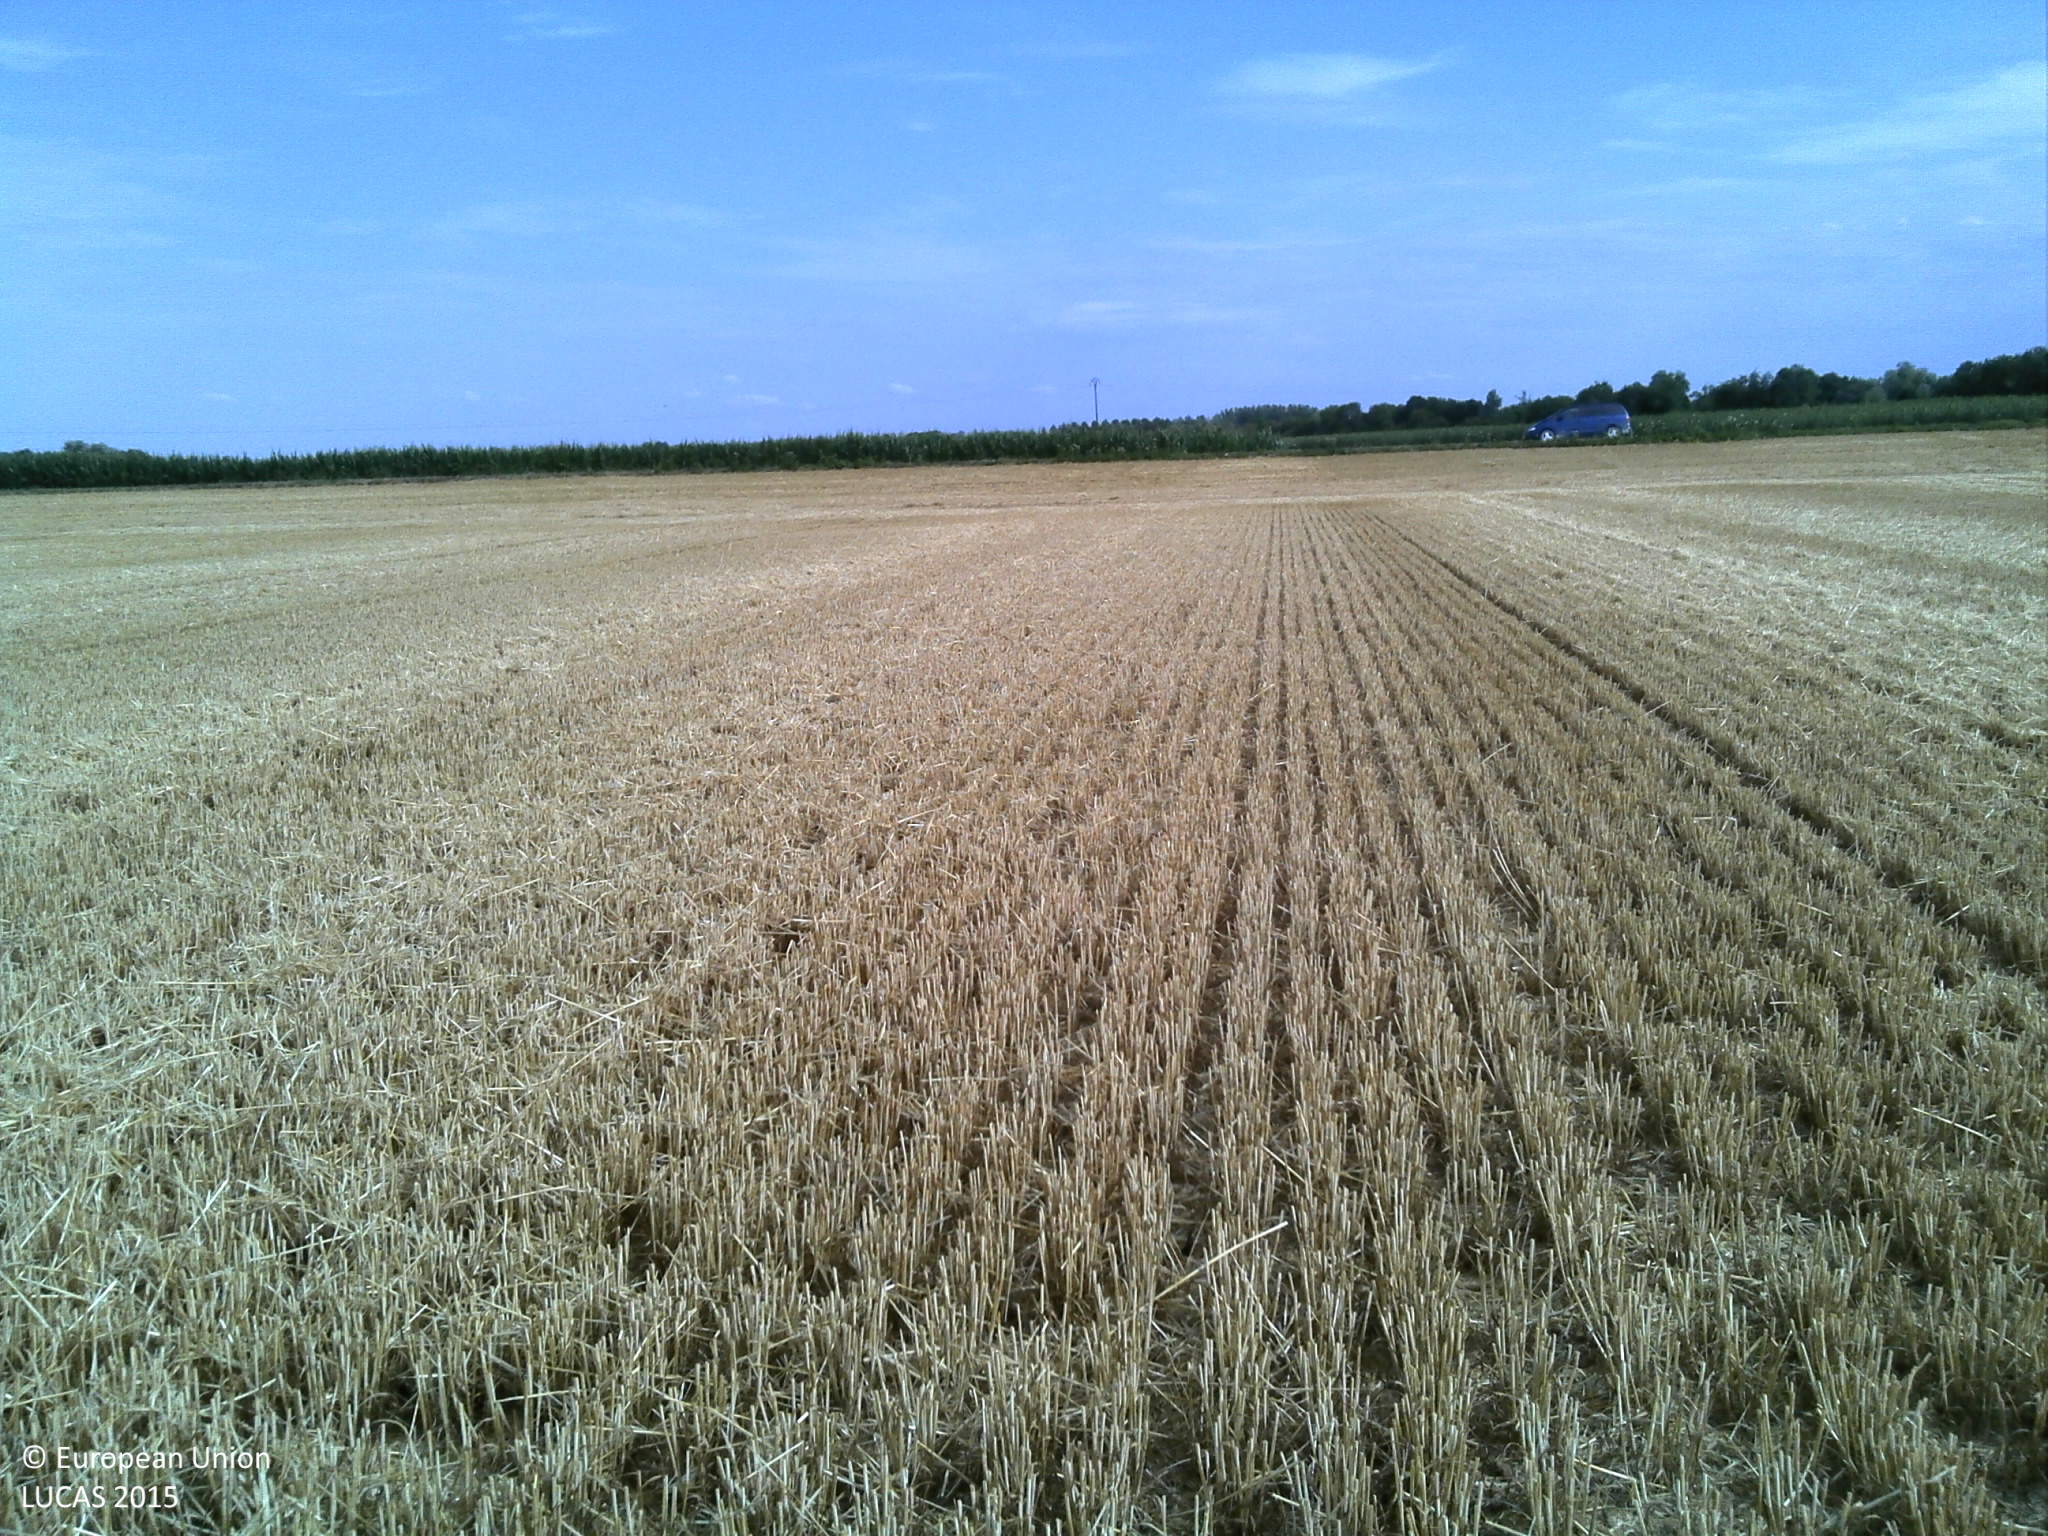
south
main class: Cropland
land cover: Common wheat
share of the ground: > 75 %
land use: Agriculture (excluding fallow land and kitchen gardens)
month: July
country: FR
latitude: 48.7045
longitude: 4.6026
